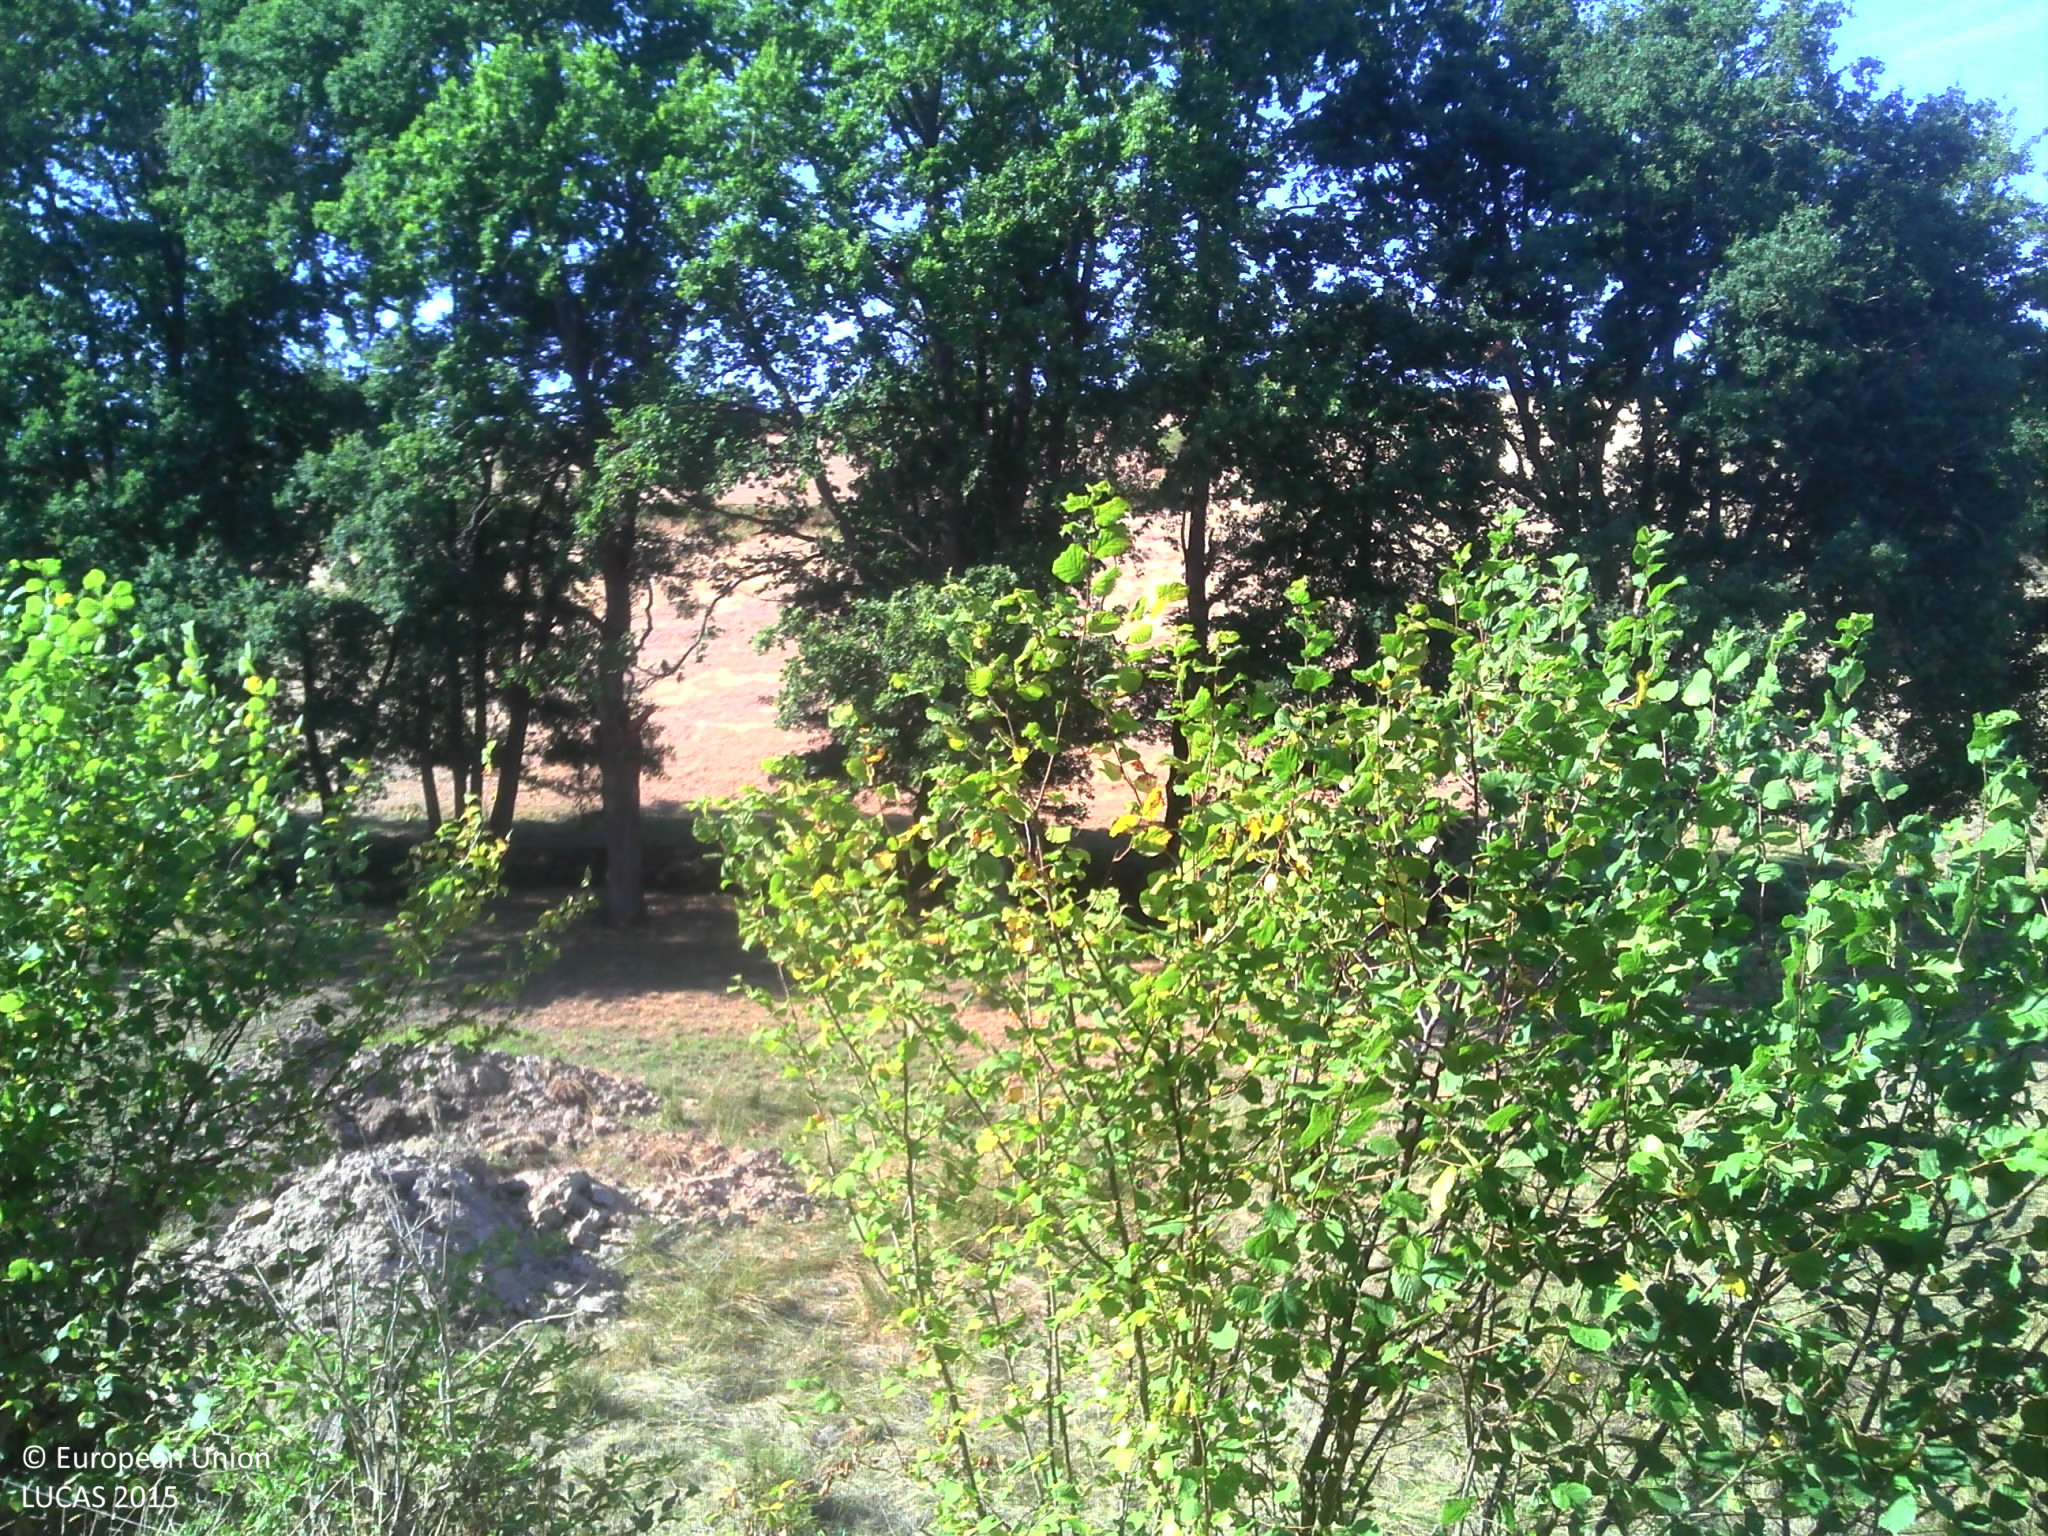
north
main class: Grassland
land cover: Grassland without tree/shrub cover
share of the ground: > 75 %
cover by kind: herbaceous plants 100 %
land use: Agriculture (excluding fallow land and kitchen gardens)
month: August
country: FR
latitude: 46.6802
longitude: 4.5232
